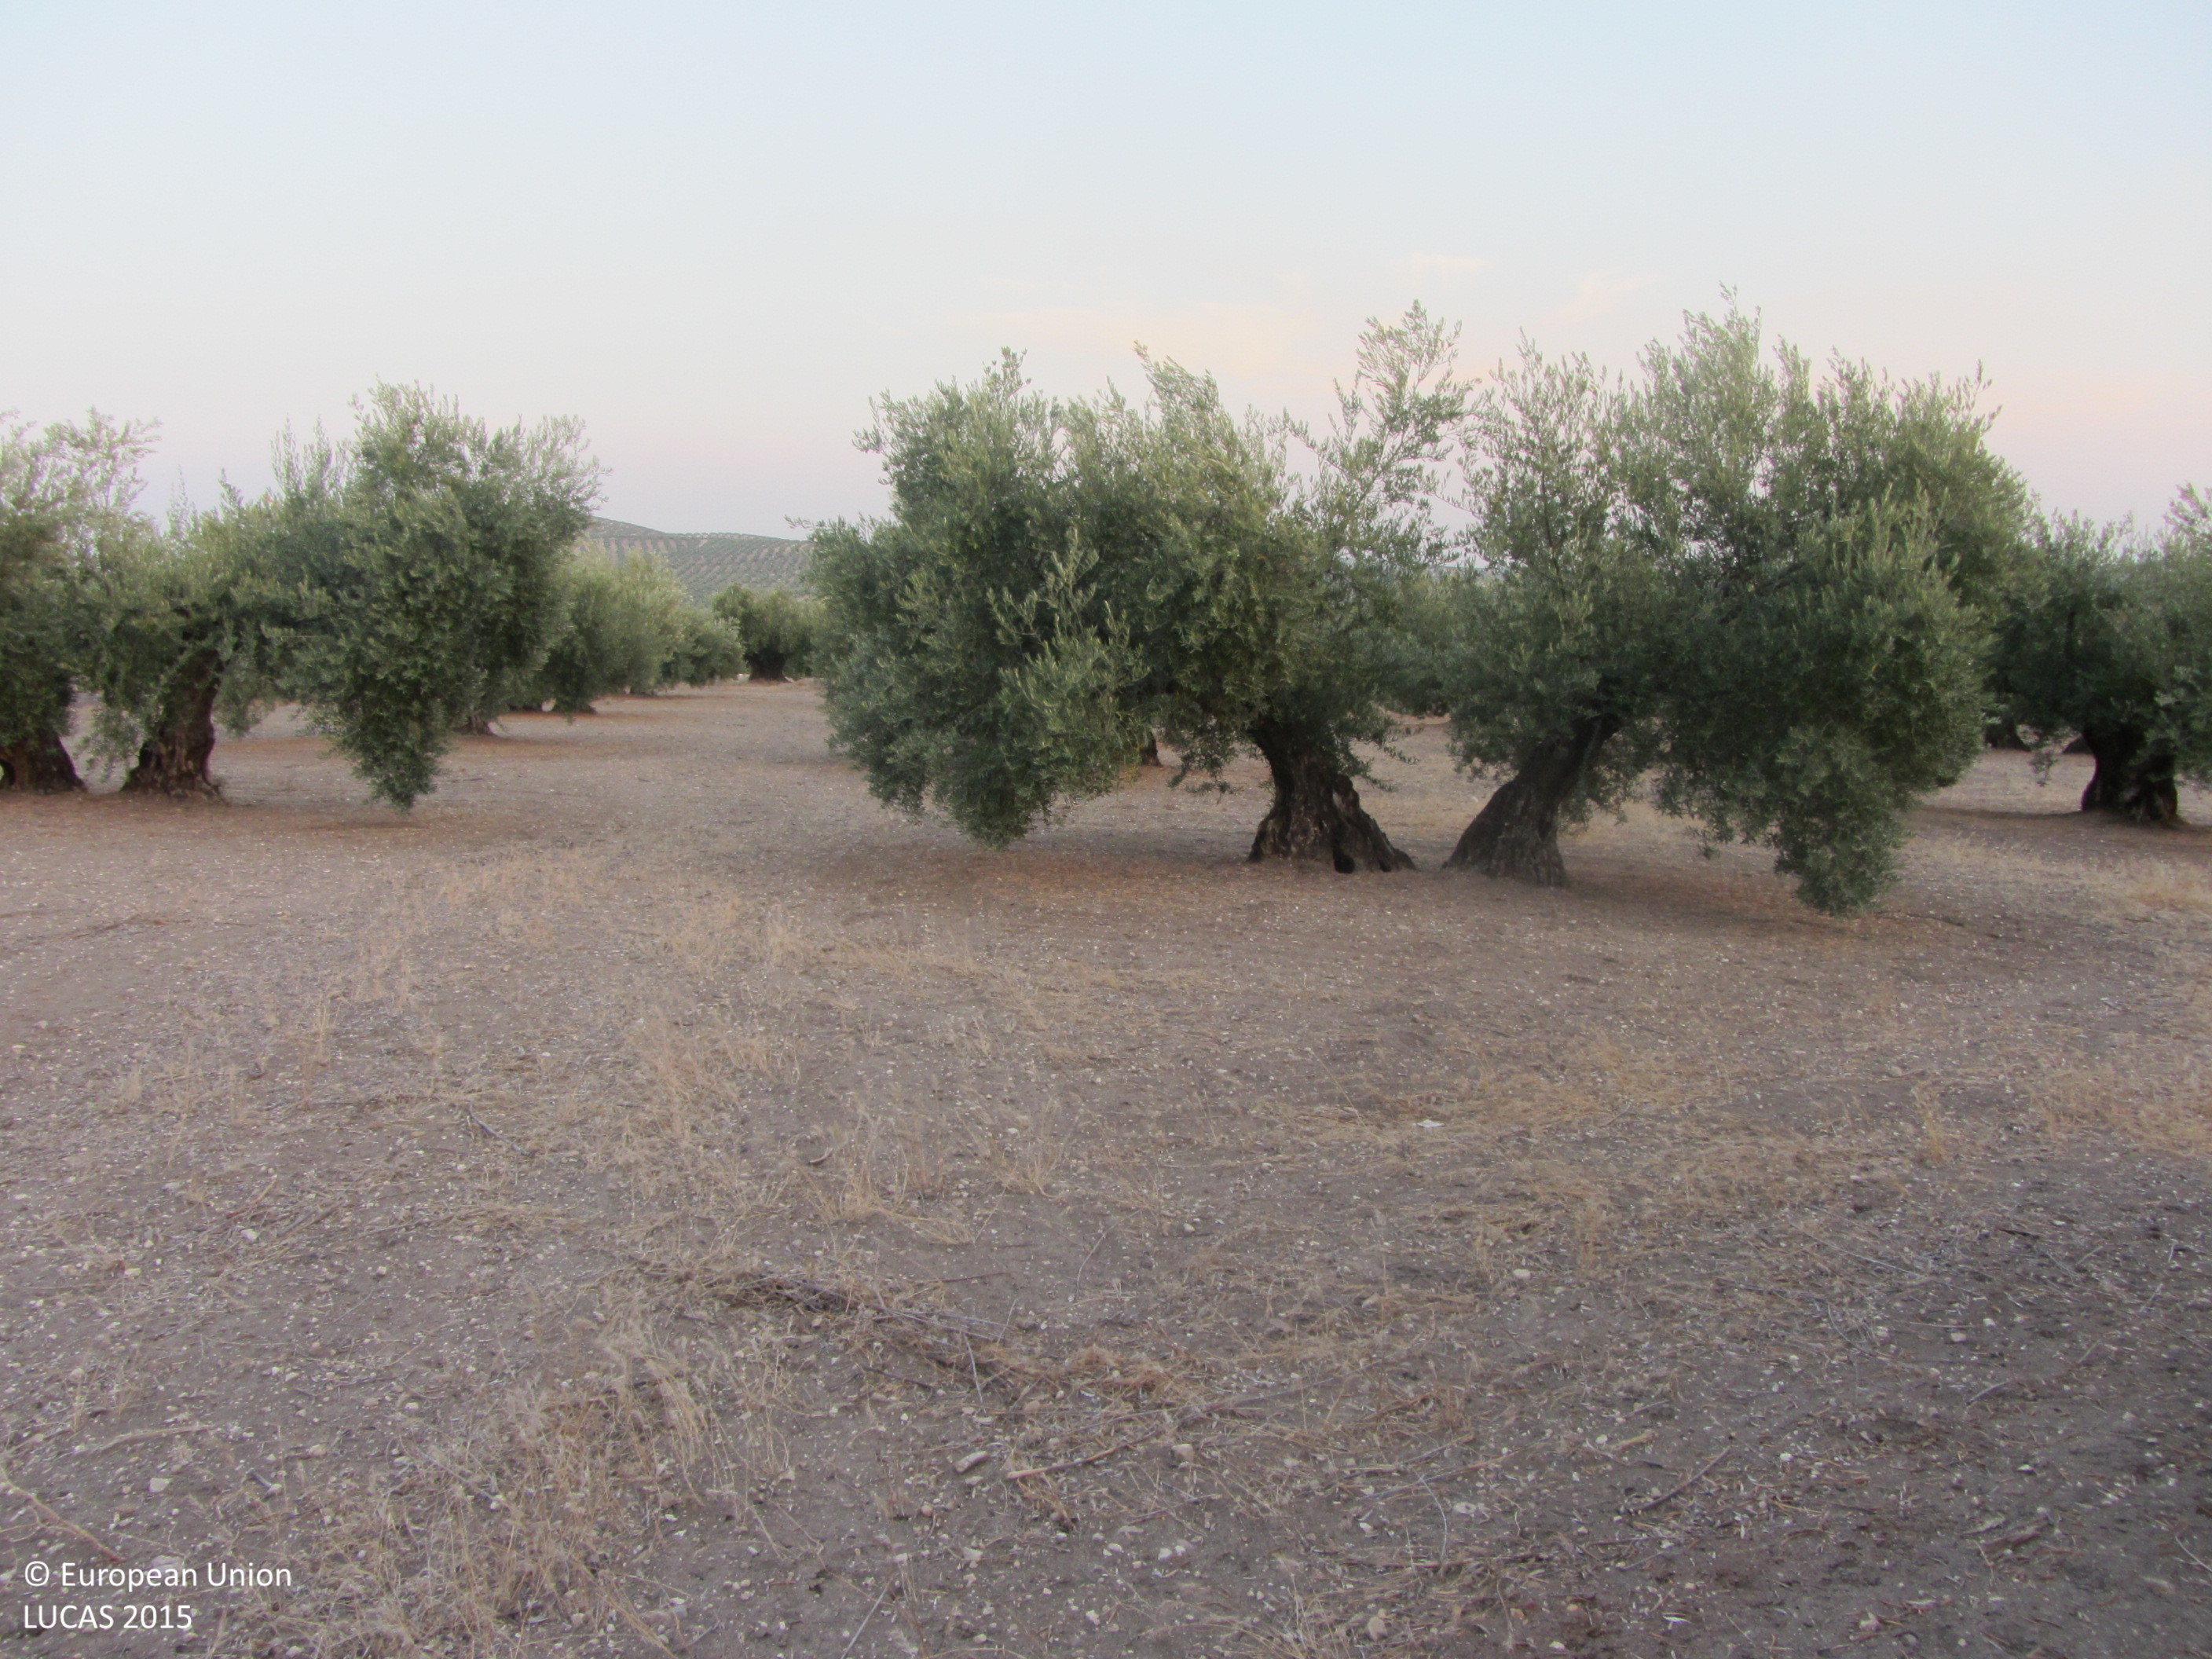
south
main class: Cropland
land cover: Olive groves
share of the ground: 25 - 50 %
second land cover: Other bare soil
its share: > 75 %
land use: Agriculture (excluding fallow land and kitchen gardens)
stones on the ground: < 10 %
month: July
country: ES
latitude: 37.8374
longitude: -4.1755
